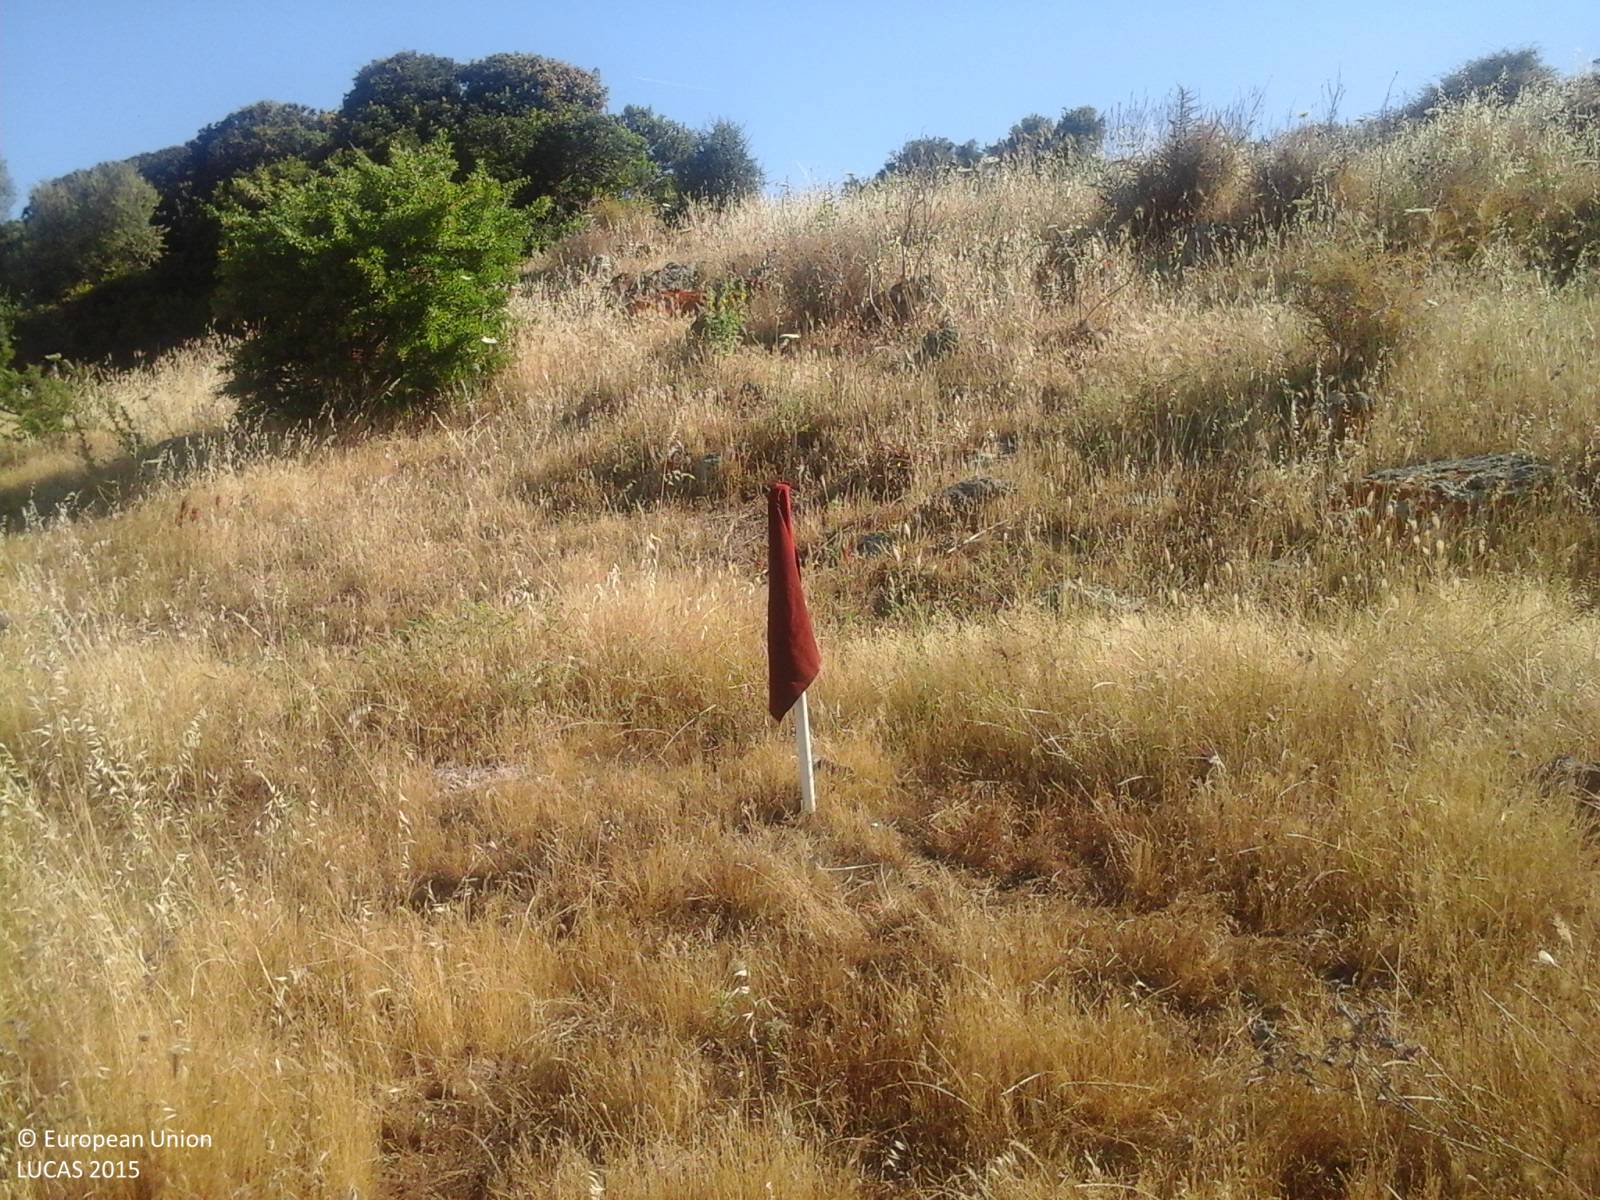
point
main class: Grassland
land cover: Grassland with sparse tree/shrub cover
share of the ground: > 75 %
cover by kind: herbaceous plants 90 %, broadleaved forest trees 5 %, shrubs 5 %
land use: Agriculture (excluding fallow land and kitchen gardens)
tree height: < 5 m
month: June
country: IT
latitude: 40.5992
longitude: 8.4595
